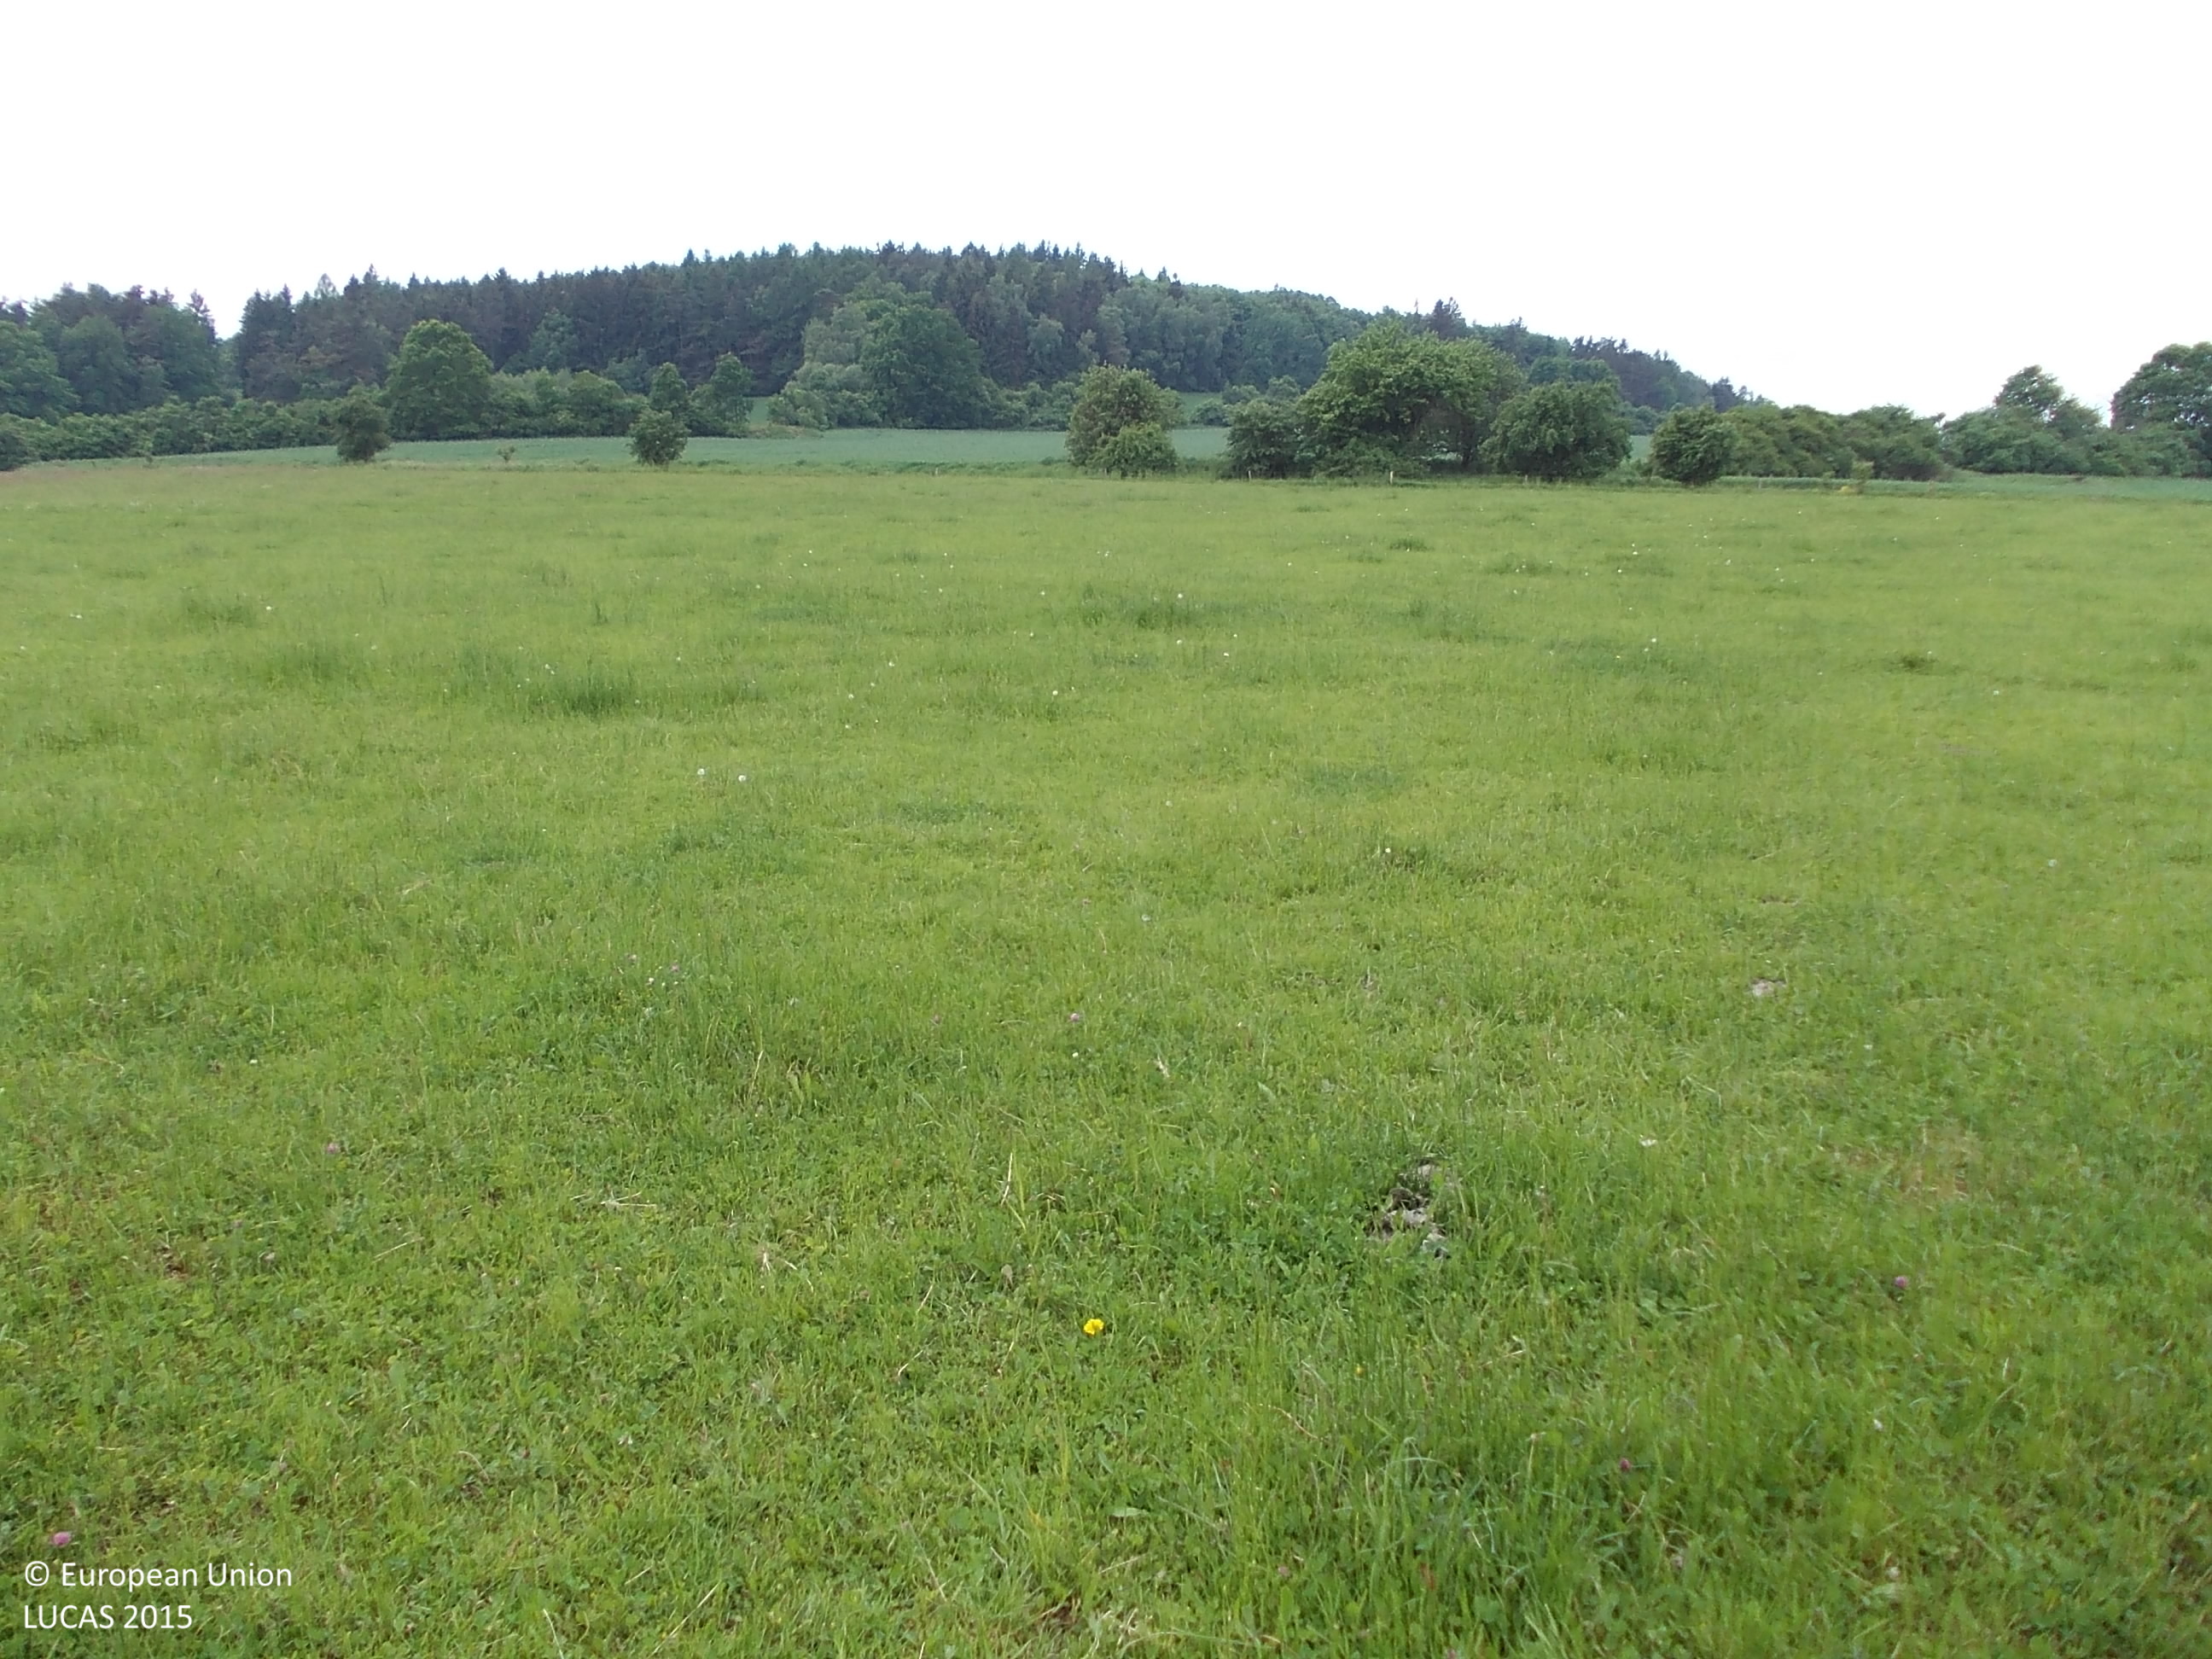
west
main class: Grassland
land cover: Grassland without tree/shrub cover
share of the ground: > 75 %
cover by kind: herbaceous plants 100 %
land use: Agriculture (excluding fallow land and kitchen gardens)
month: May
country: CZ
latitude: 49.3076
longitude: 13.8928
